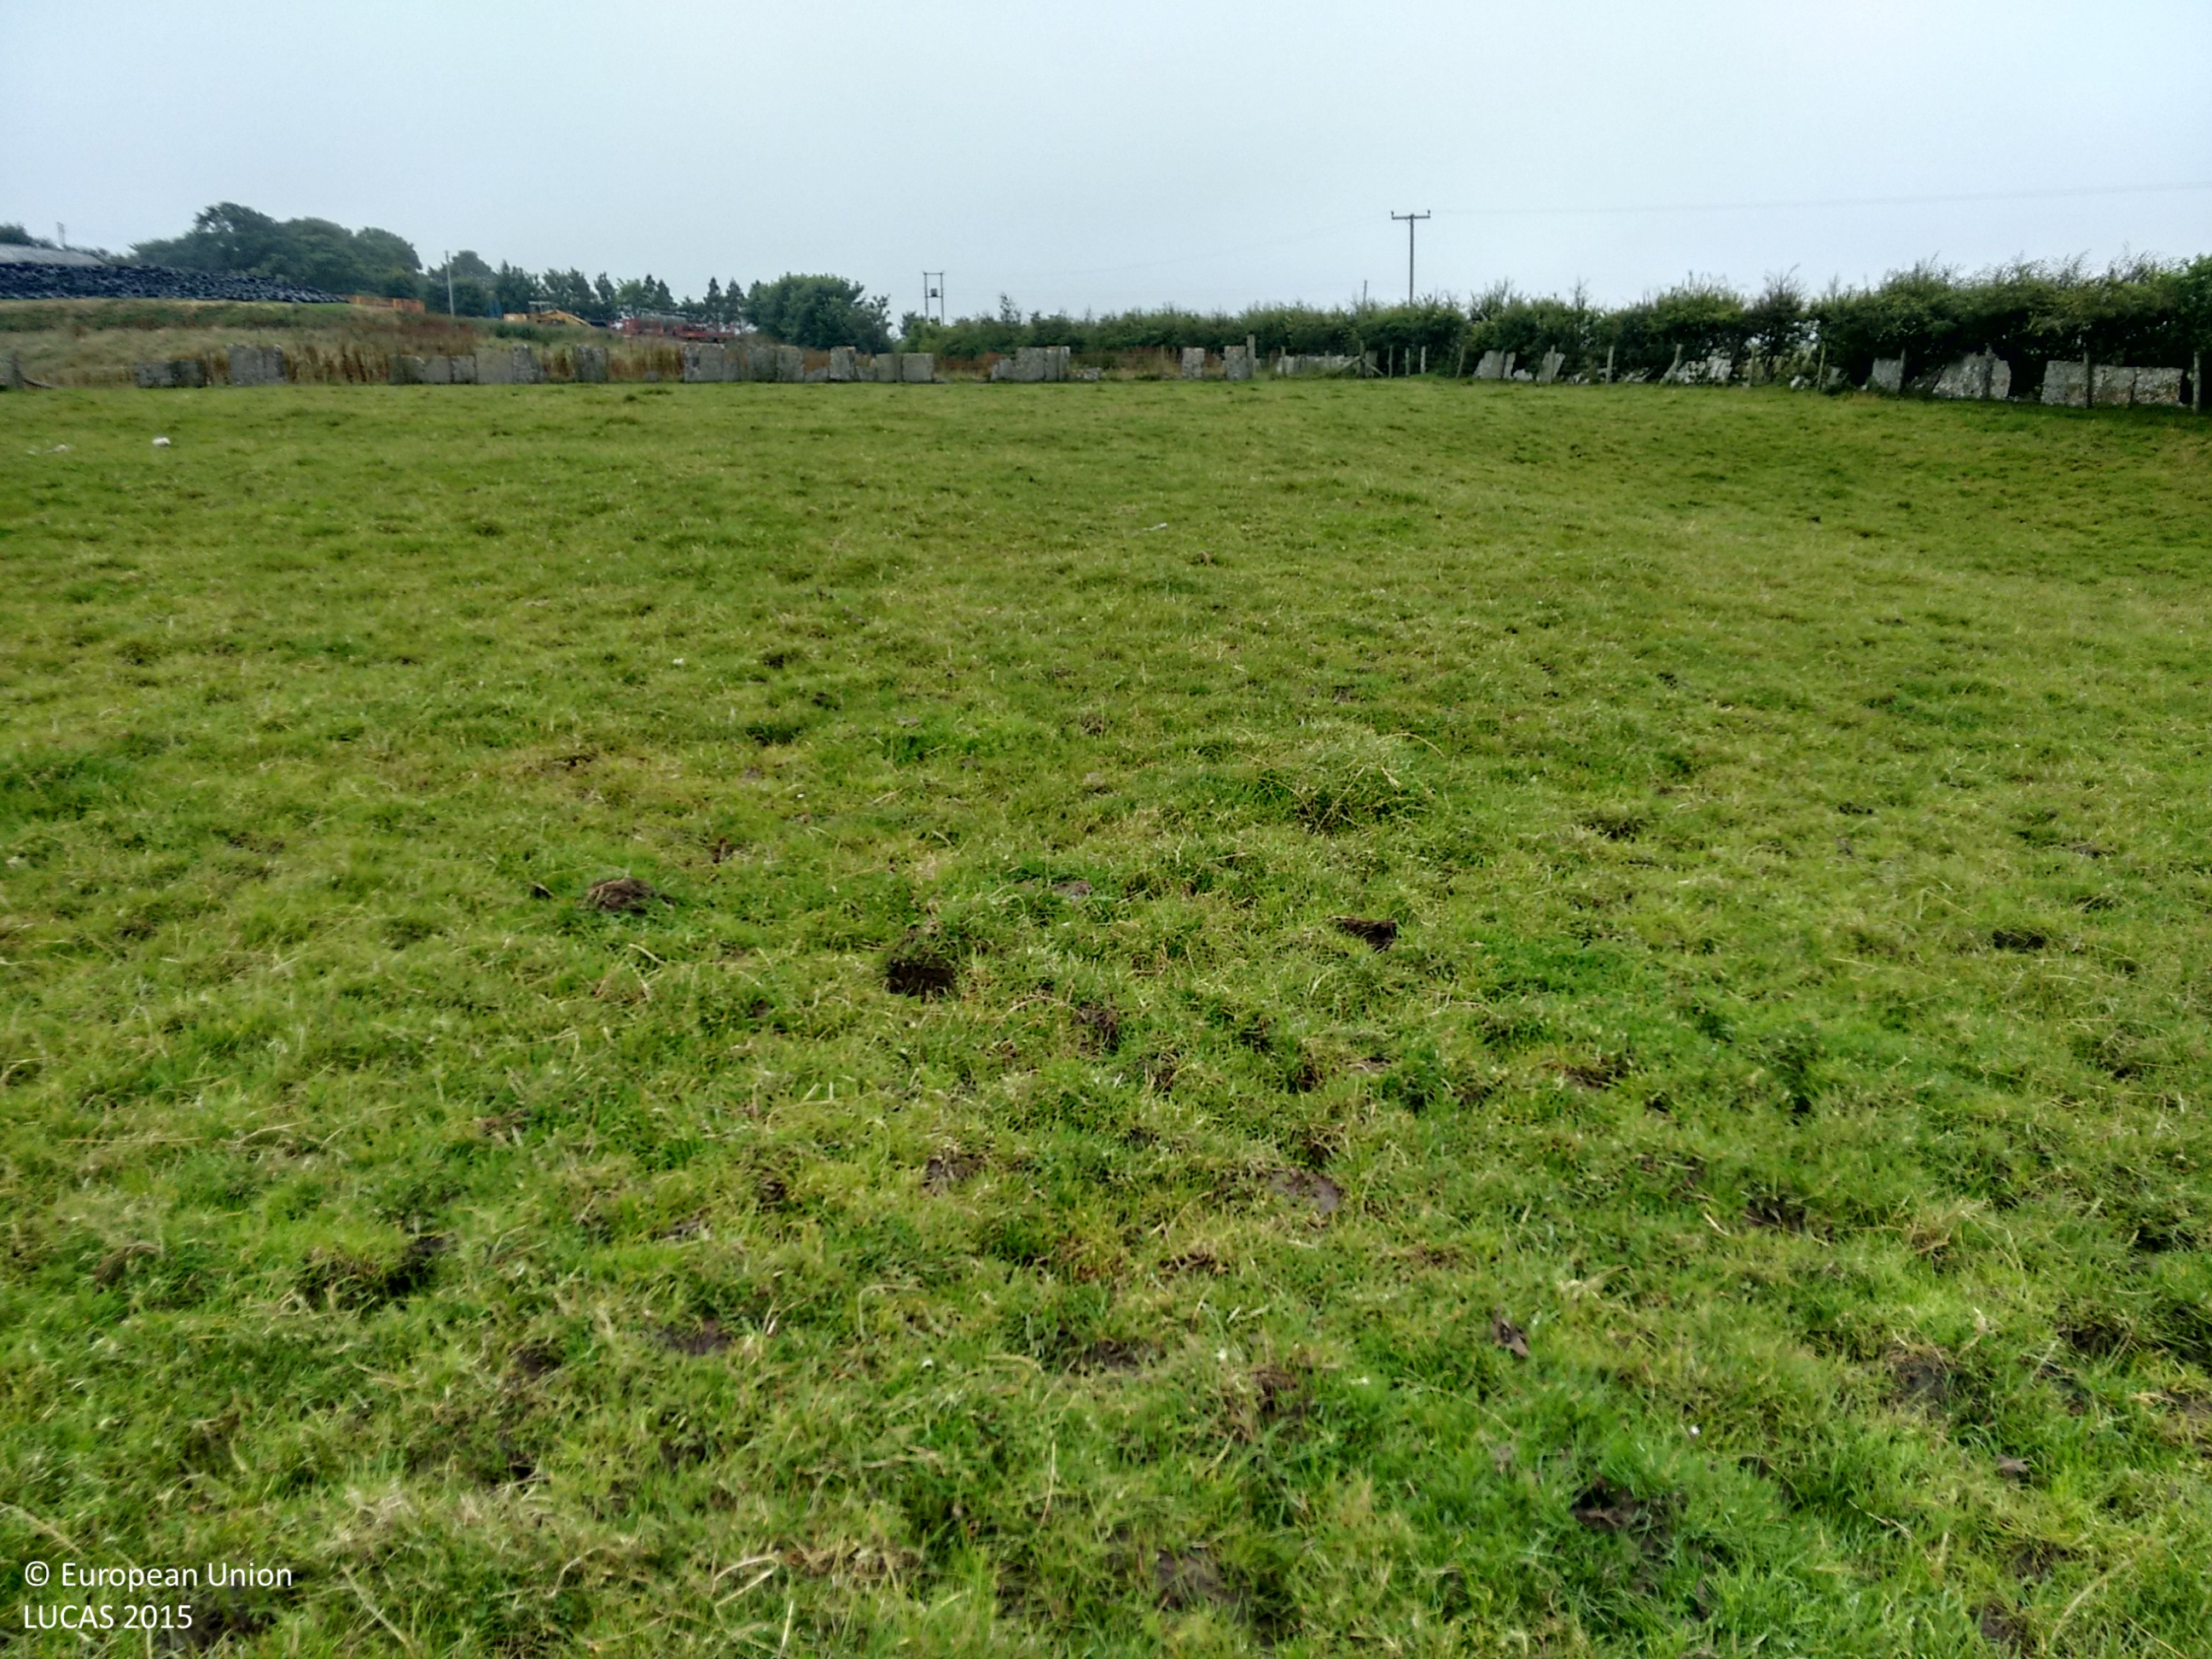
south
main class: Grassland
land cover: Grassland without tree/shrub cover
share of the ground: > 75 %
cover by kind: herbaceous plants 100 %
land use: Agriculture (excluding fallow land and kitchen gardens)
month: August
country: GB
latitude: 58.4526
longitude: -3.2727
